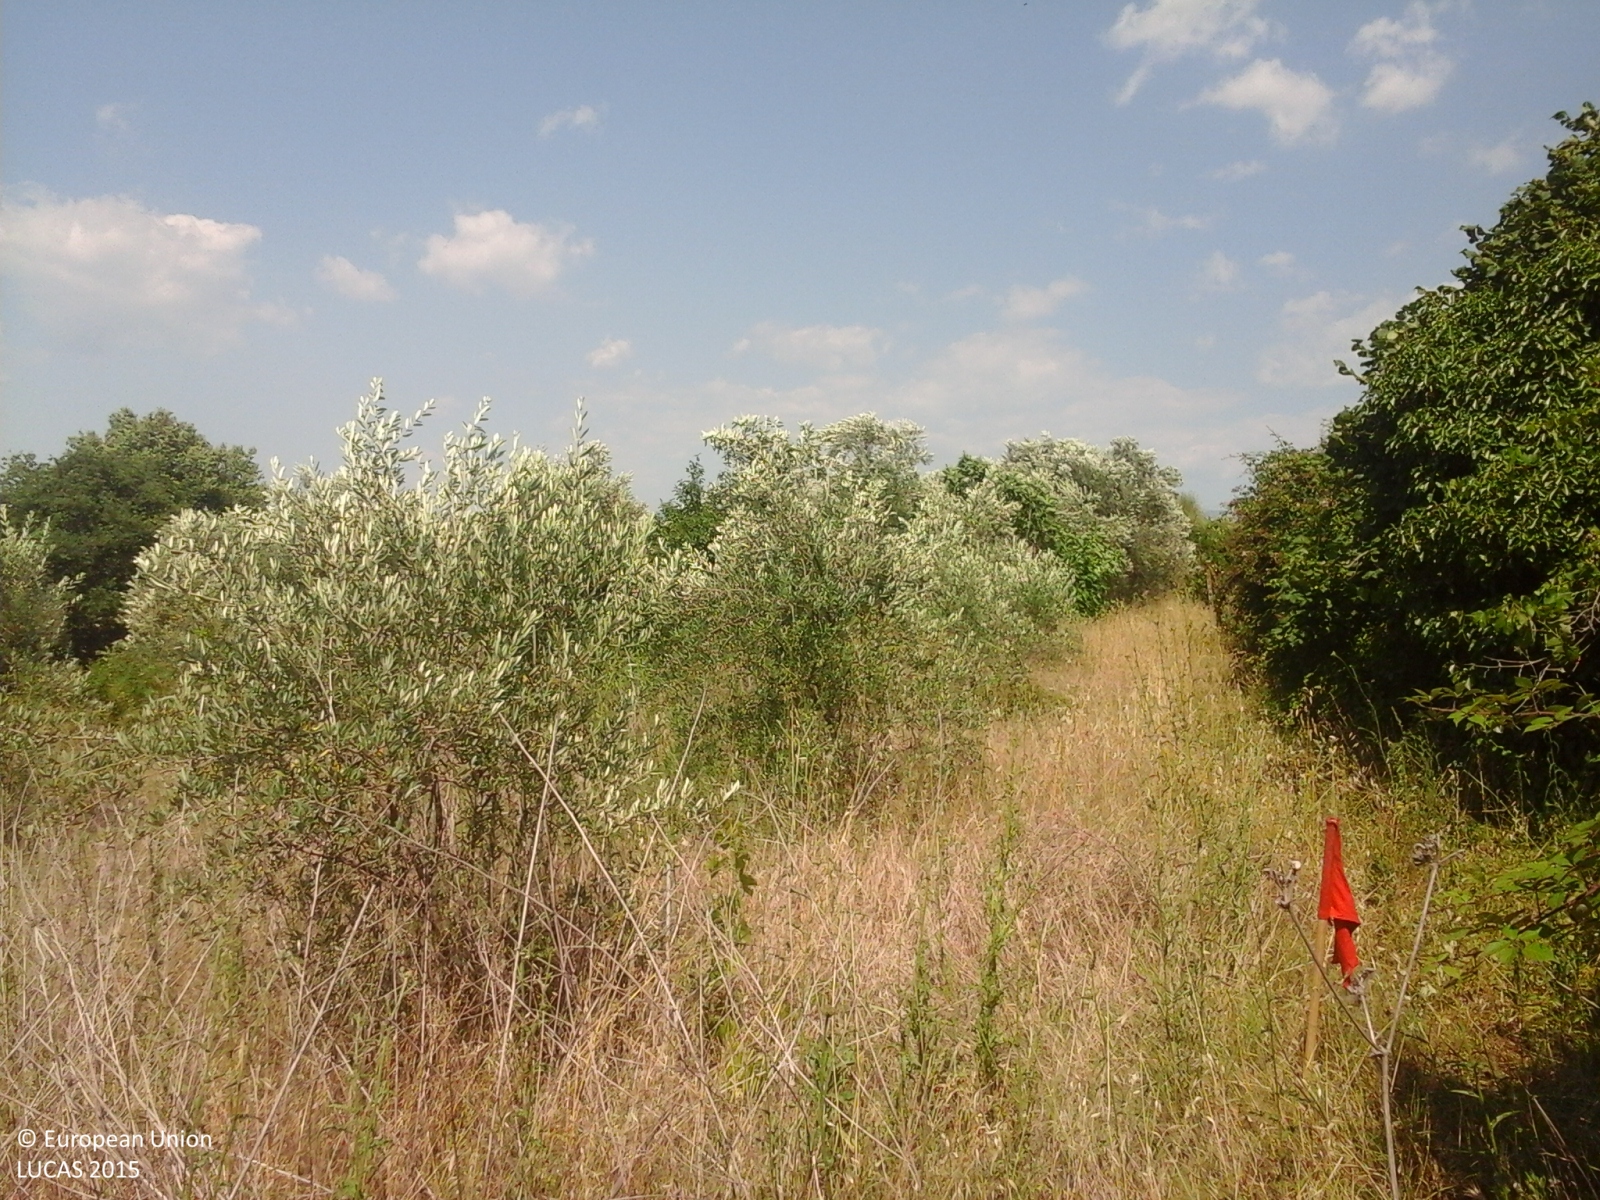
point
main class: Cropland
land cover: Olive groves
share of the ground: 25 - 50 %
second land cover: Grassland without tree/shrub cover
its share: > 75 %
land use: Agriculture (excluding fallow land and kitchen gardens)
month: July
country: IT
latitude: 41.8395
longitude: 12.7475
